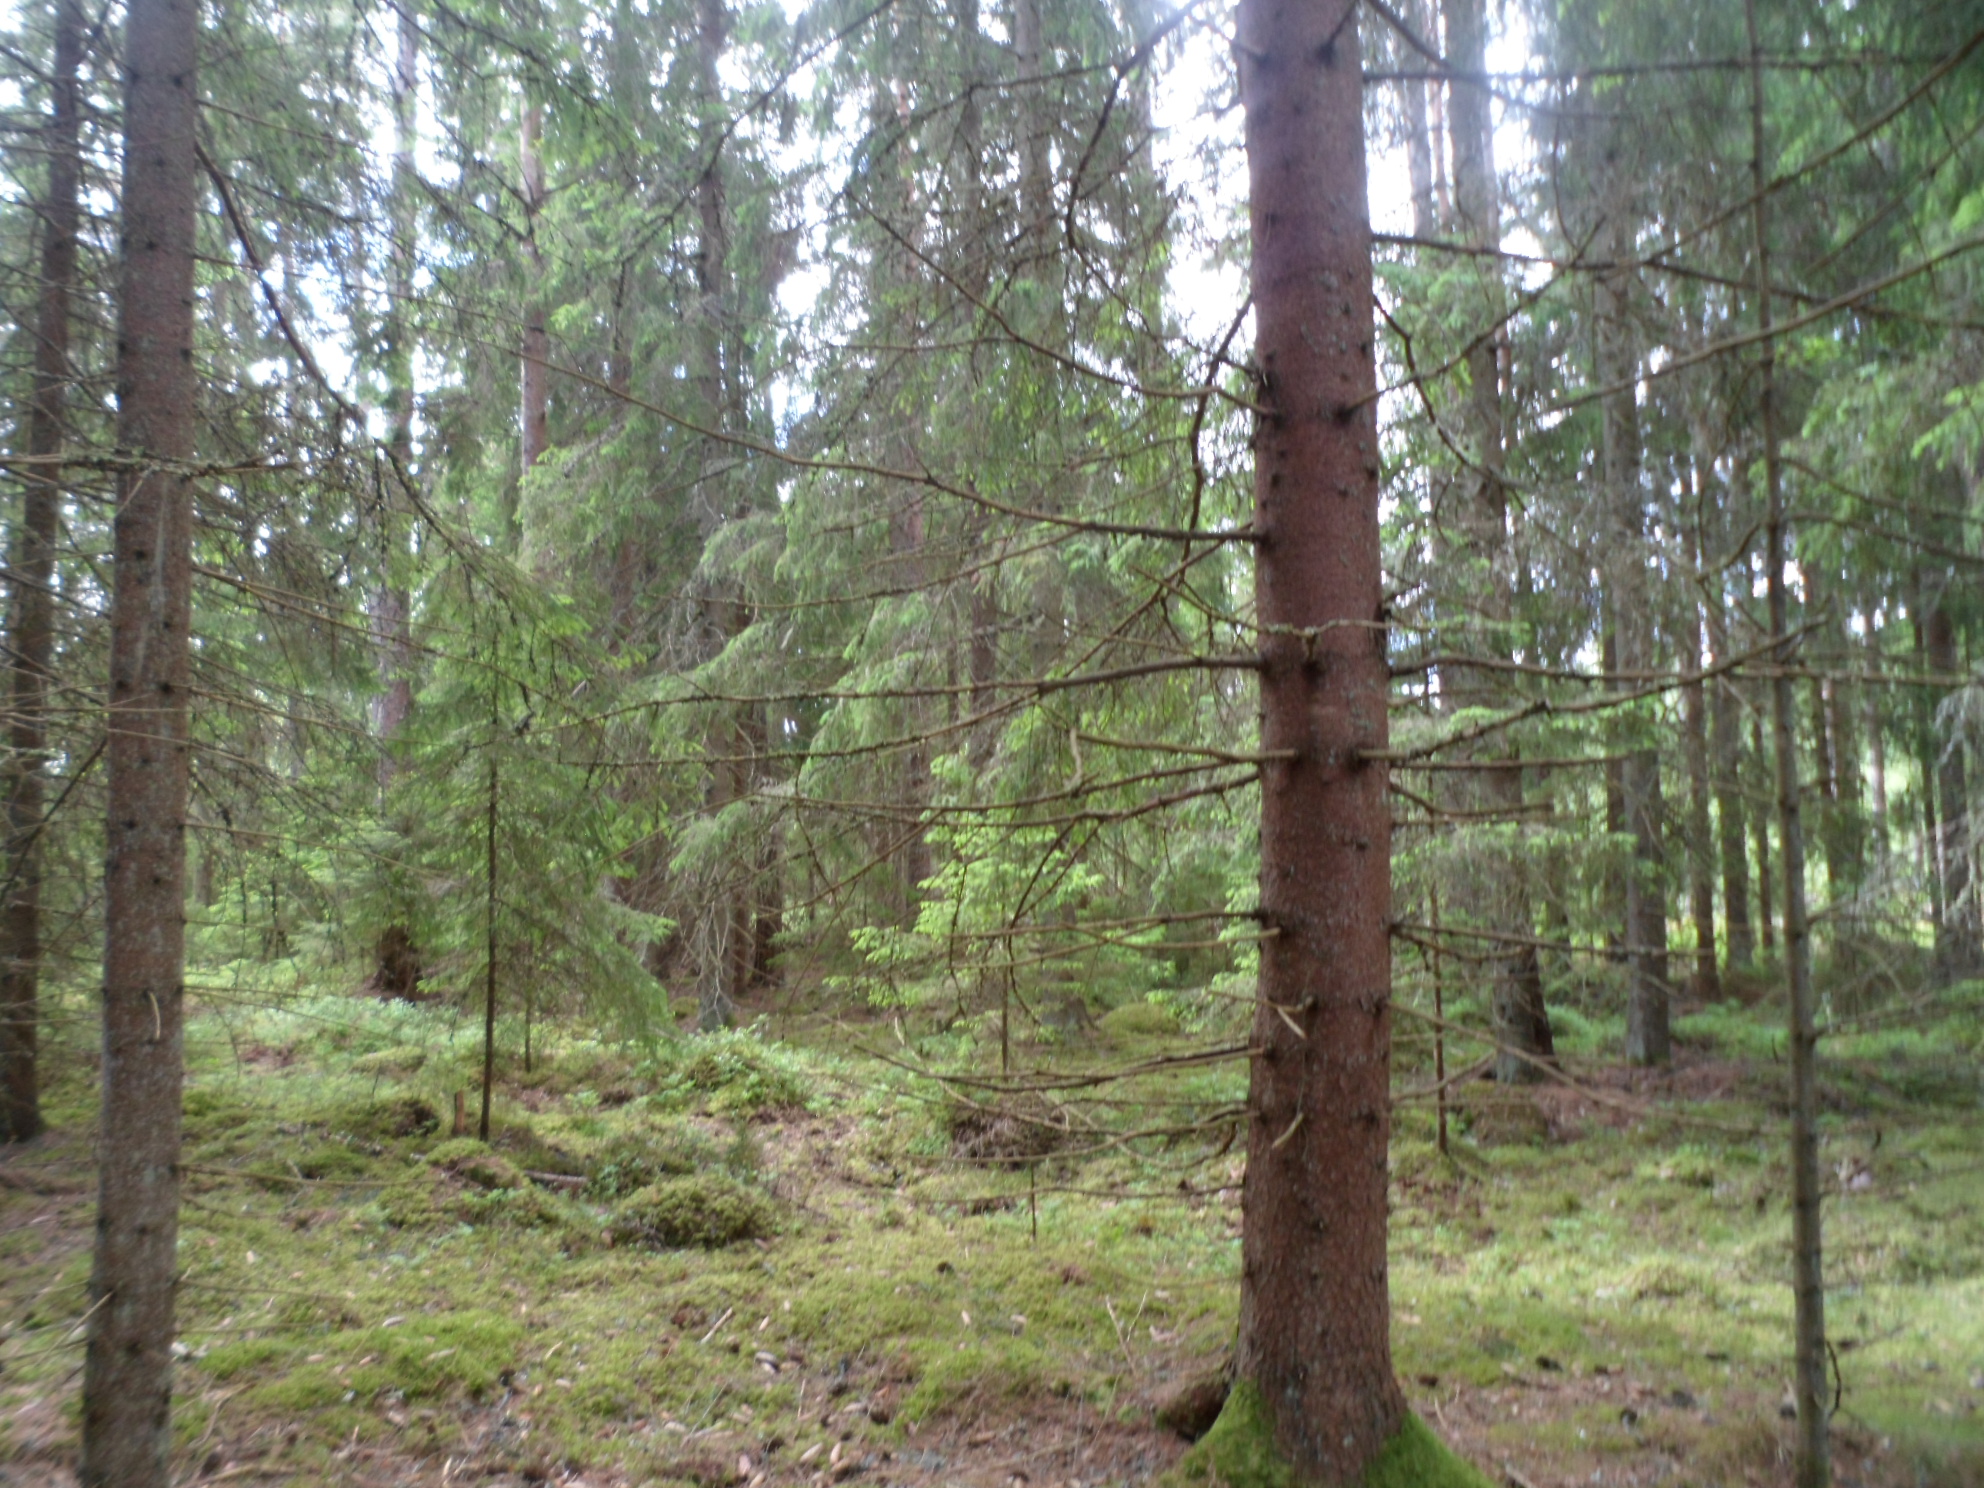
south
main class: Woodland
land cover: Spruce dominated coniferous woodland
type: boreal forest
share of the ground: > 75 %
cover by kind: coniferous forest trees 75 %, lichens and mosses 20 %, shrubs 5 %
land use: Forestry
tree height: > 5 m
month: June
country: SE
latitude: 57.1773
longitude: 14.8432
